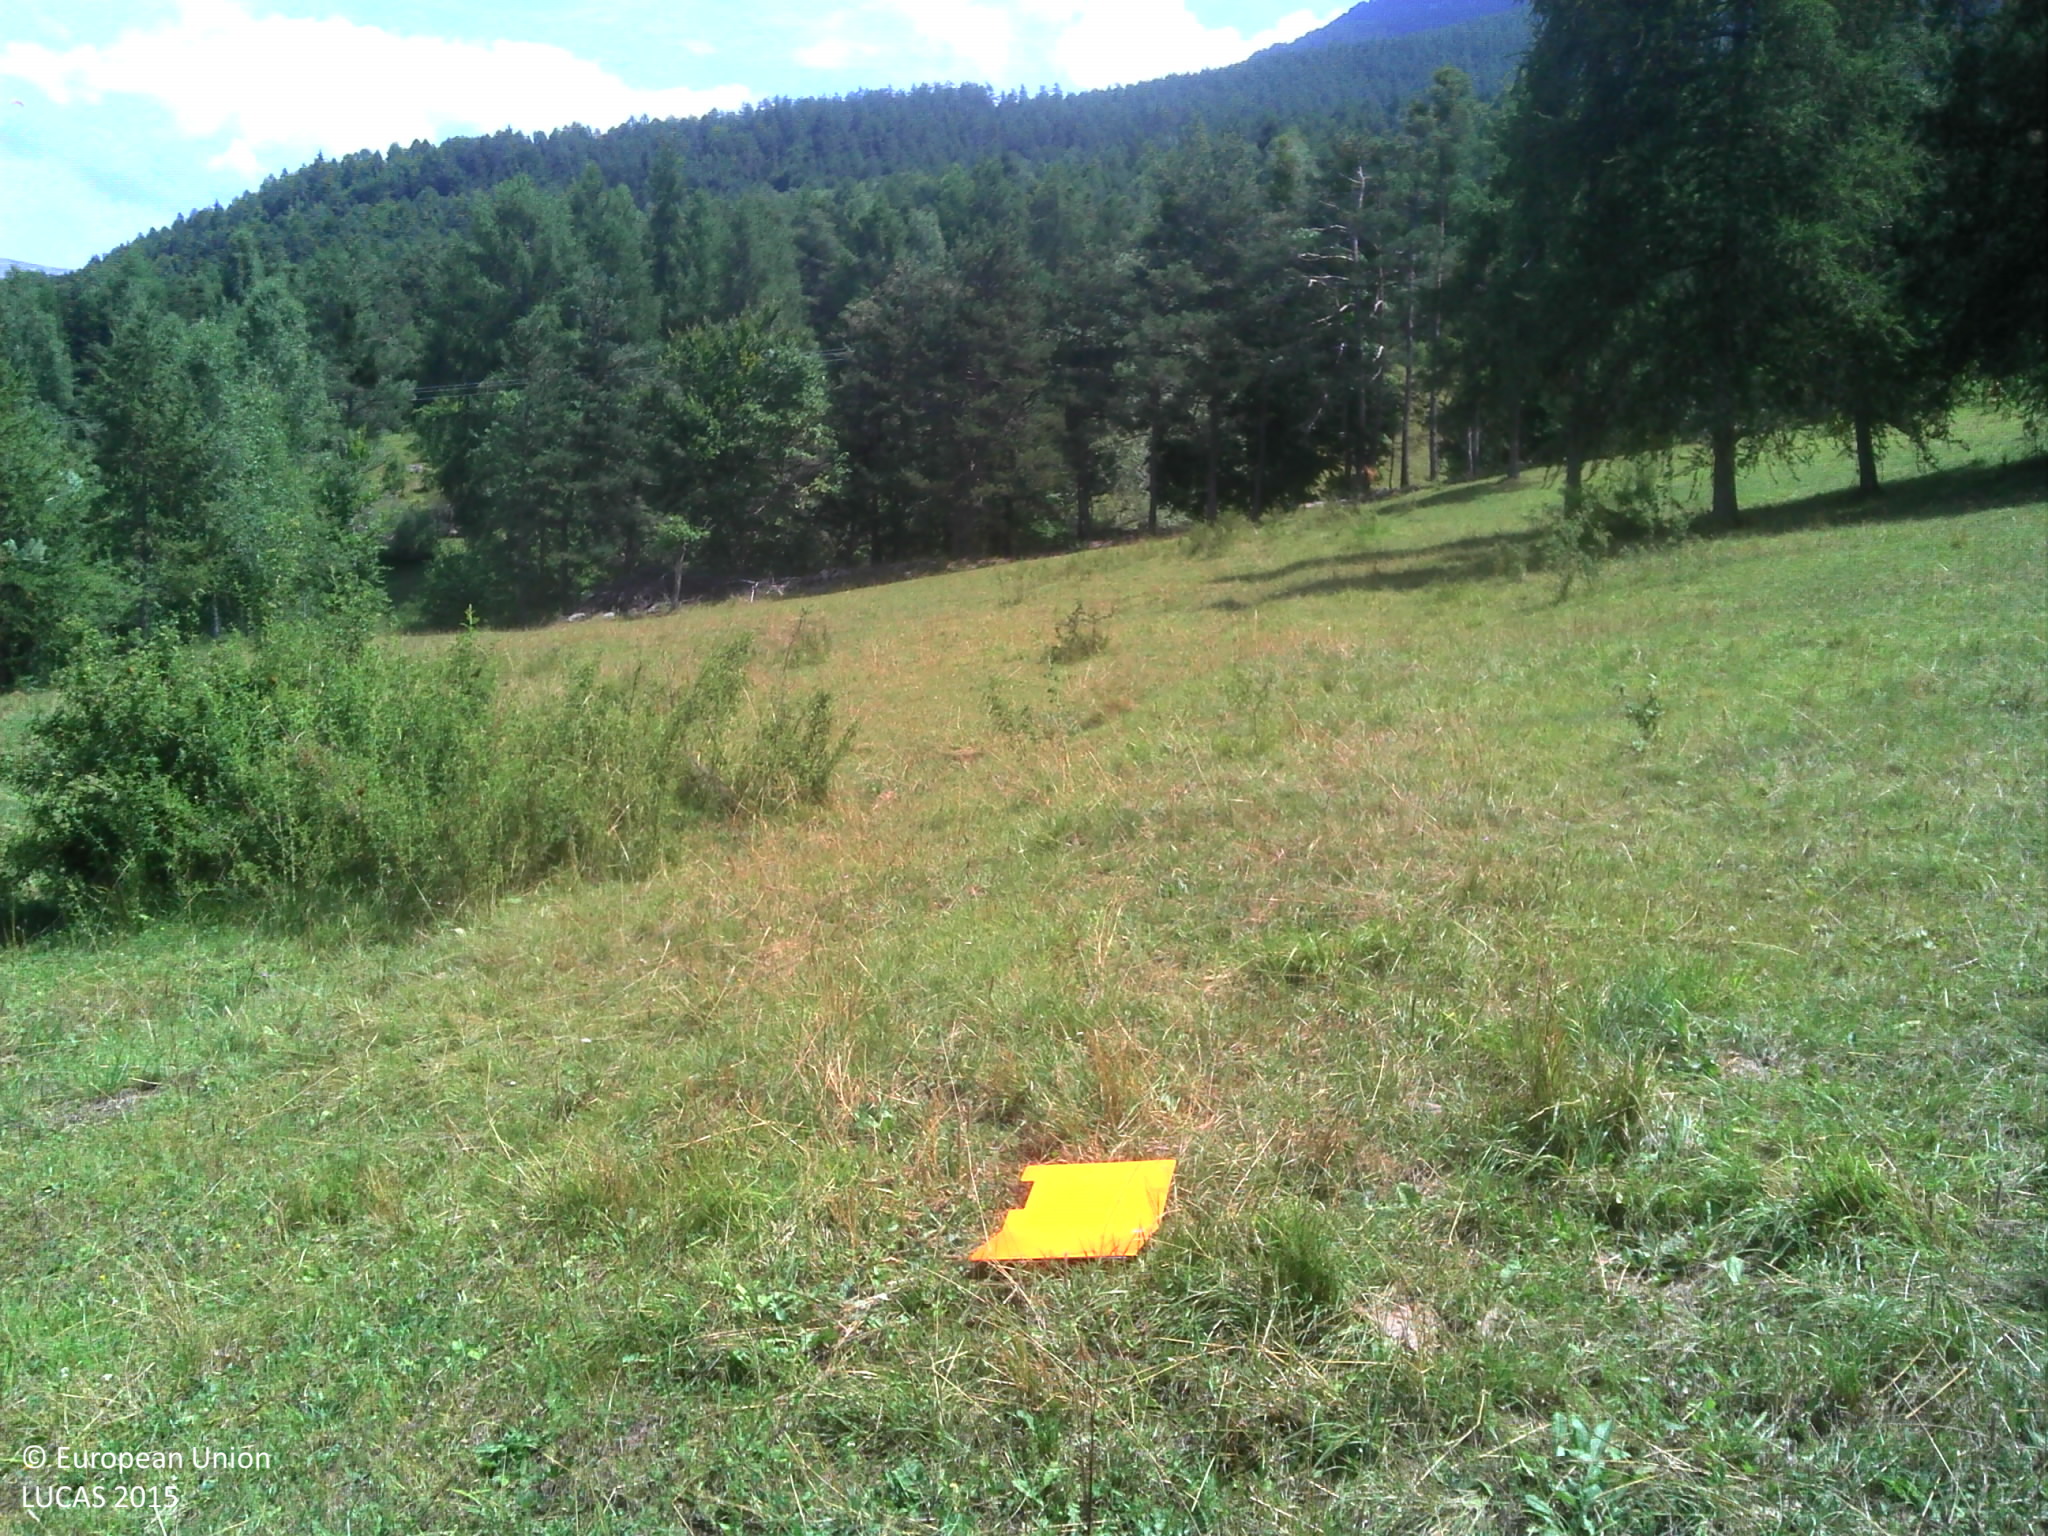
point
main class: Grassland
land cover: Grassland without tree/shrub cover
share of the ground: > 75 %
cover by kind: herbaceous plants 90 %, consolidated bare surface 10 %
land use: Agriculture (excluding fallow land and kitchen gardens)
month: July
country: FR
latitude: 44.4308
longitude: 6.3511
